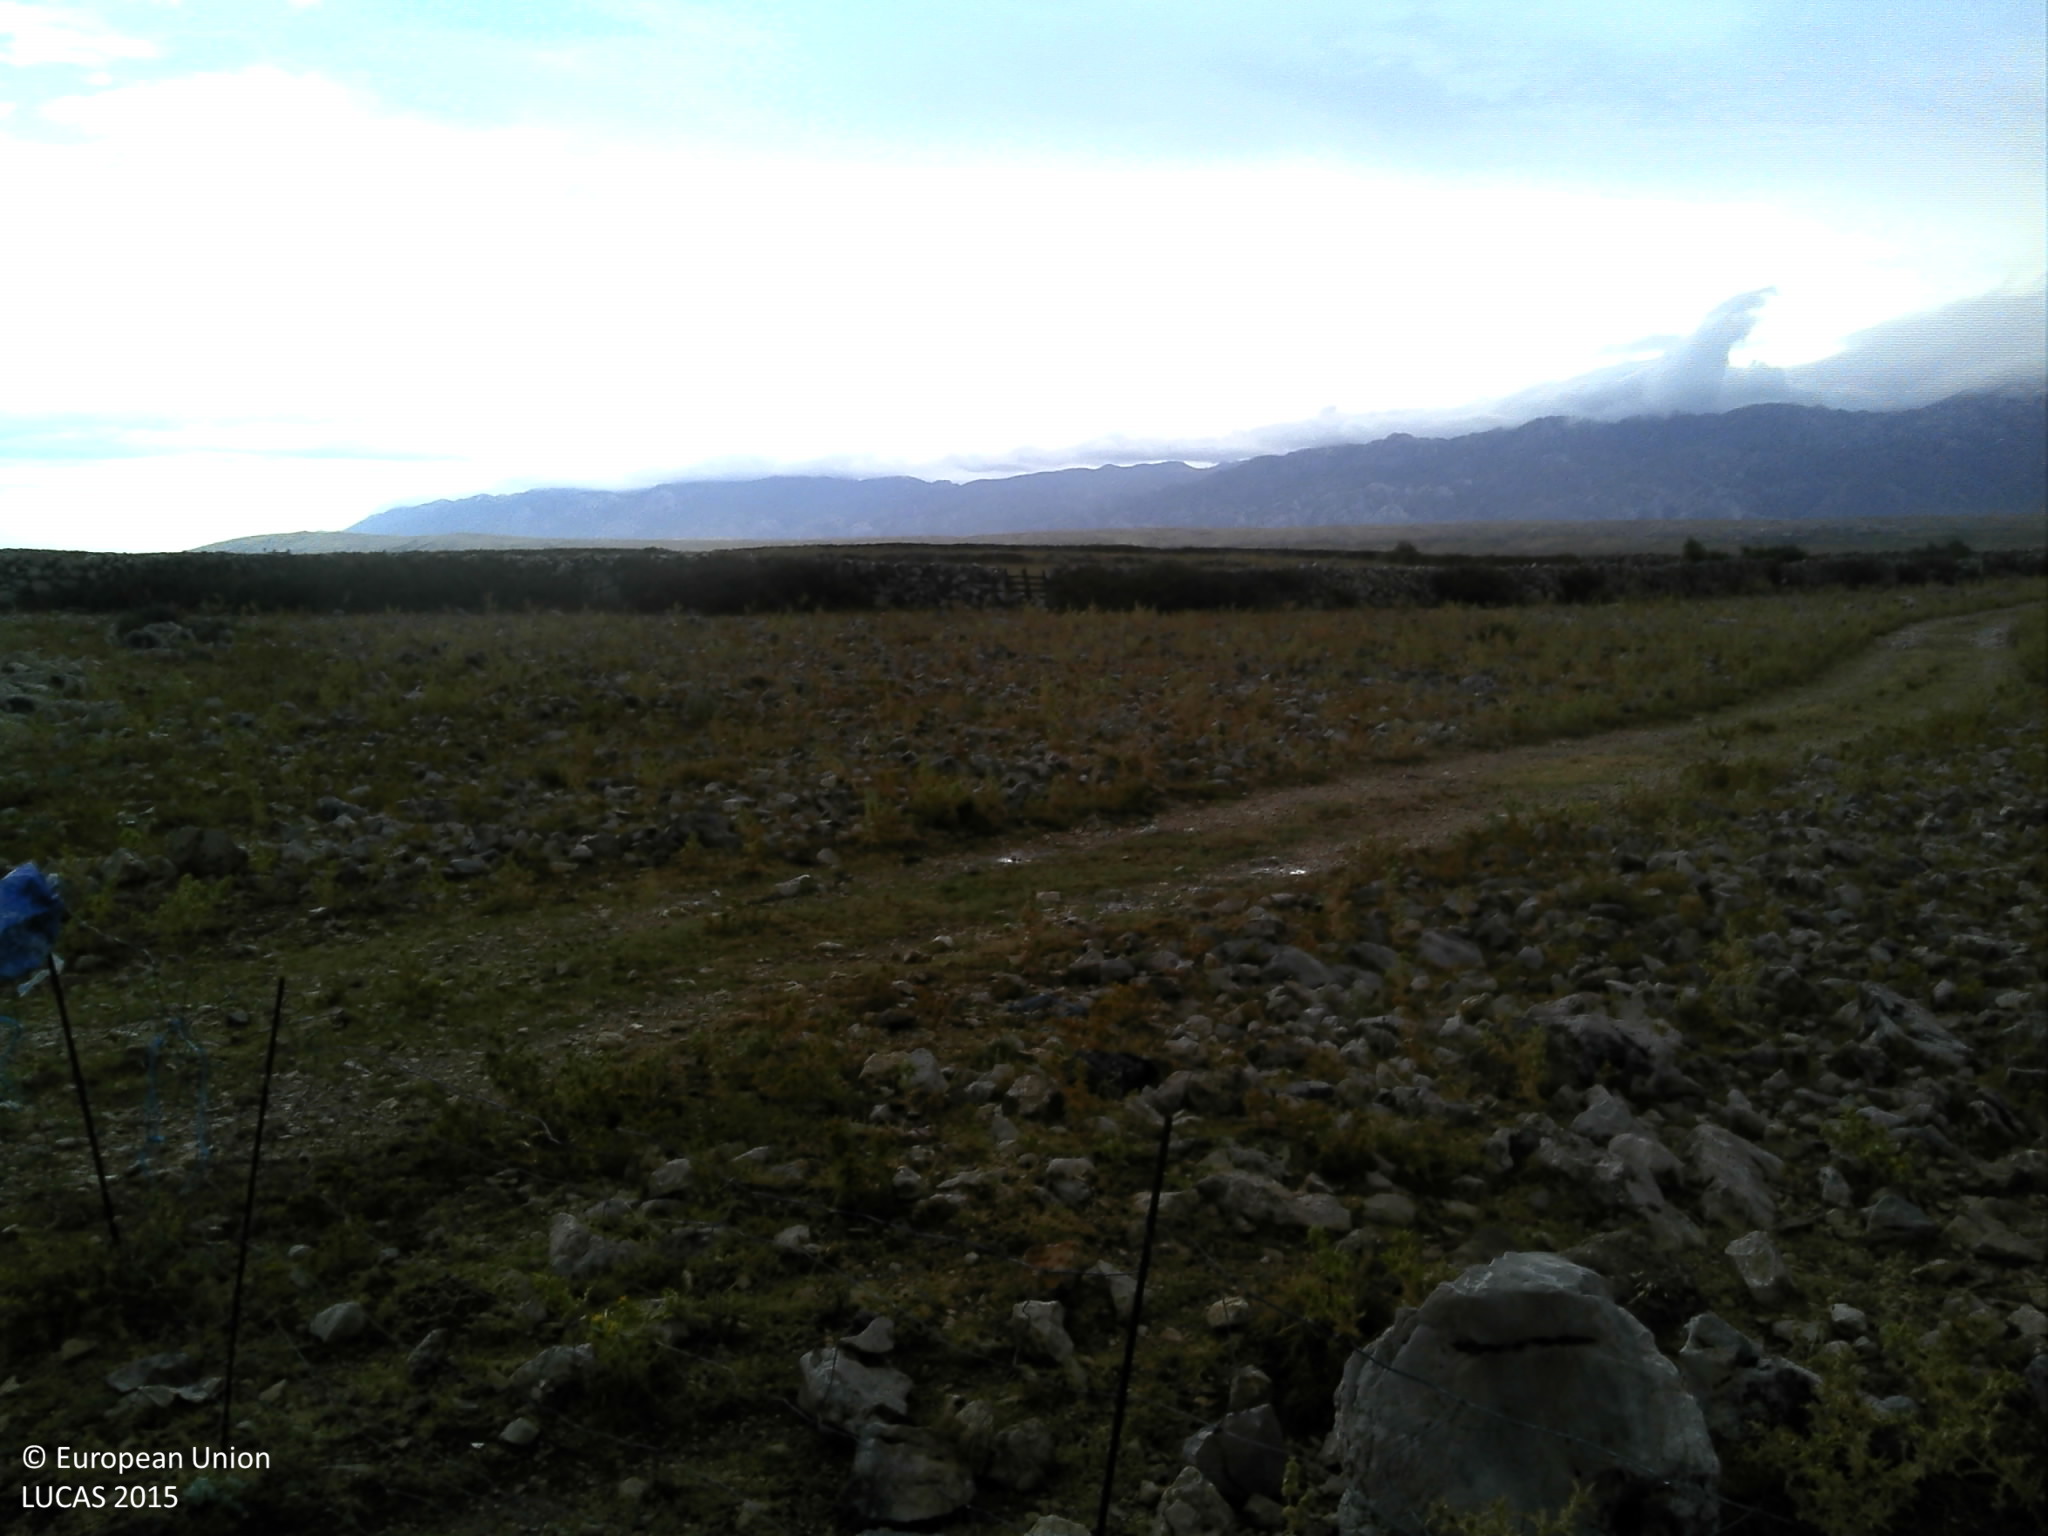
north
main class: Grassland
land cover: Grassland without tree/shrub cover
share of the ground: 50 - 75 %
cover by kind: herbaceous plants 50 %, unconsolidated bare surface 45 %, shrubs 5 %
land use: Agriculture (excluding fallow land and kitchen gardens)
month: July
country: HR
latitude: 44.3505
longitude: 15.1235
